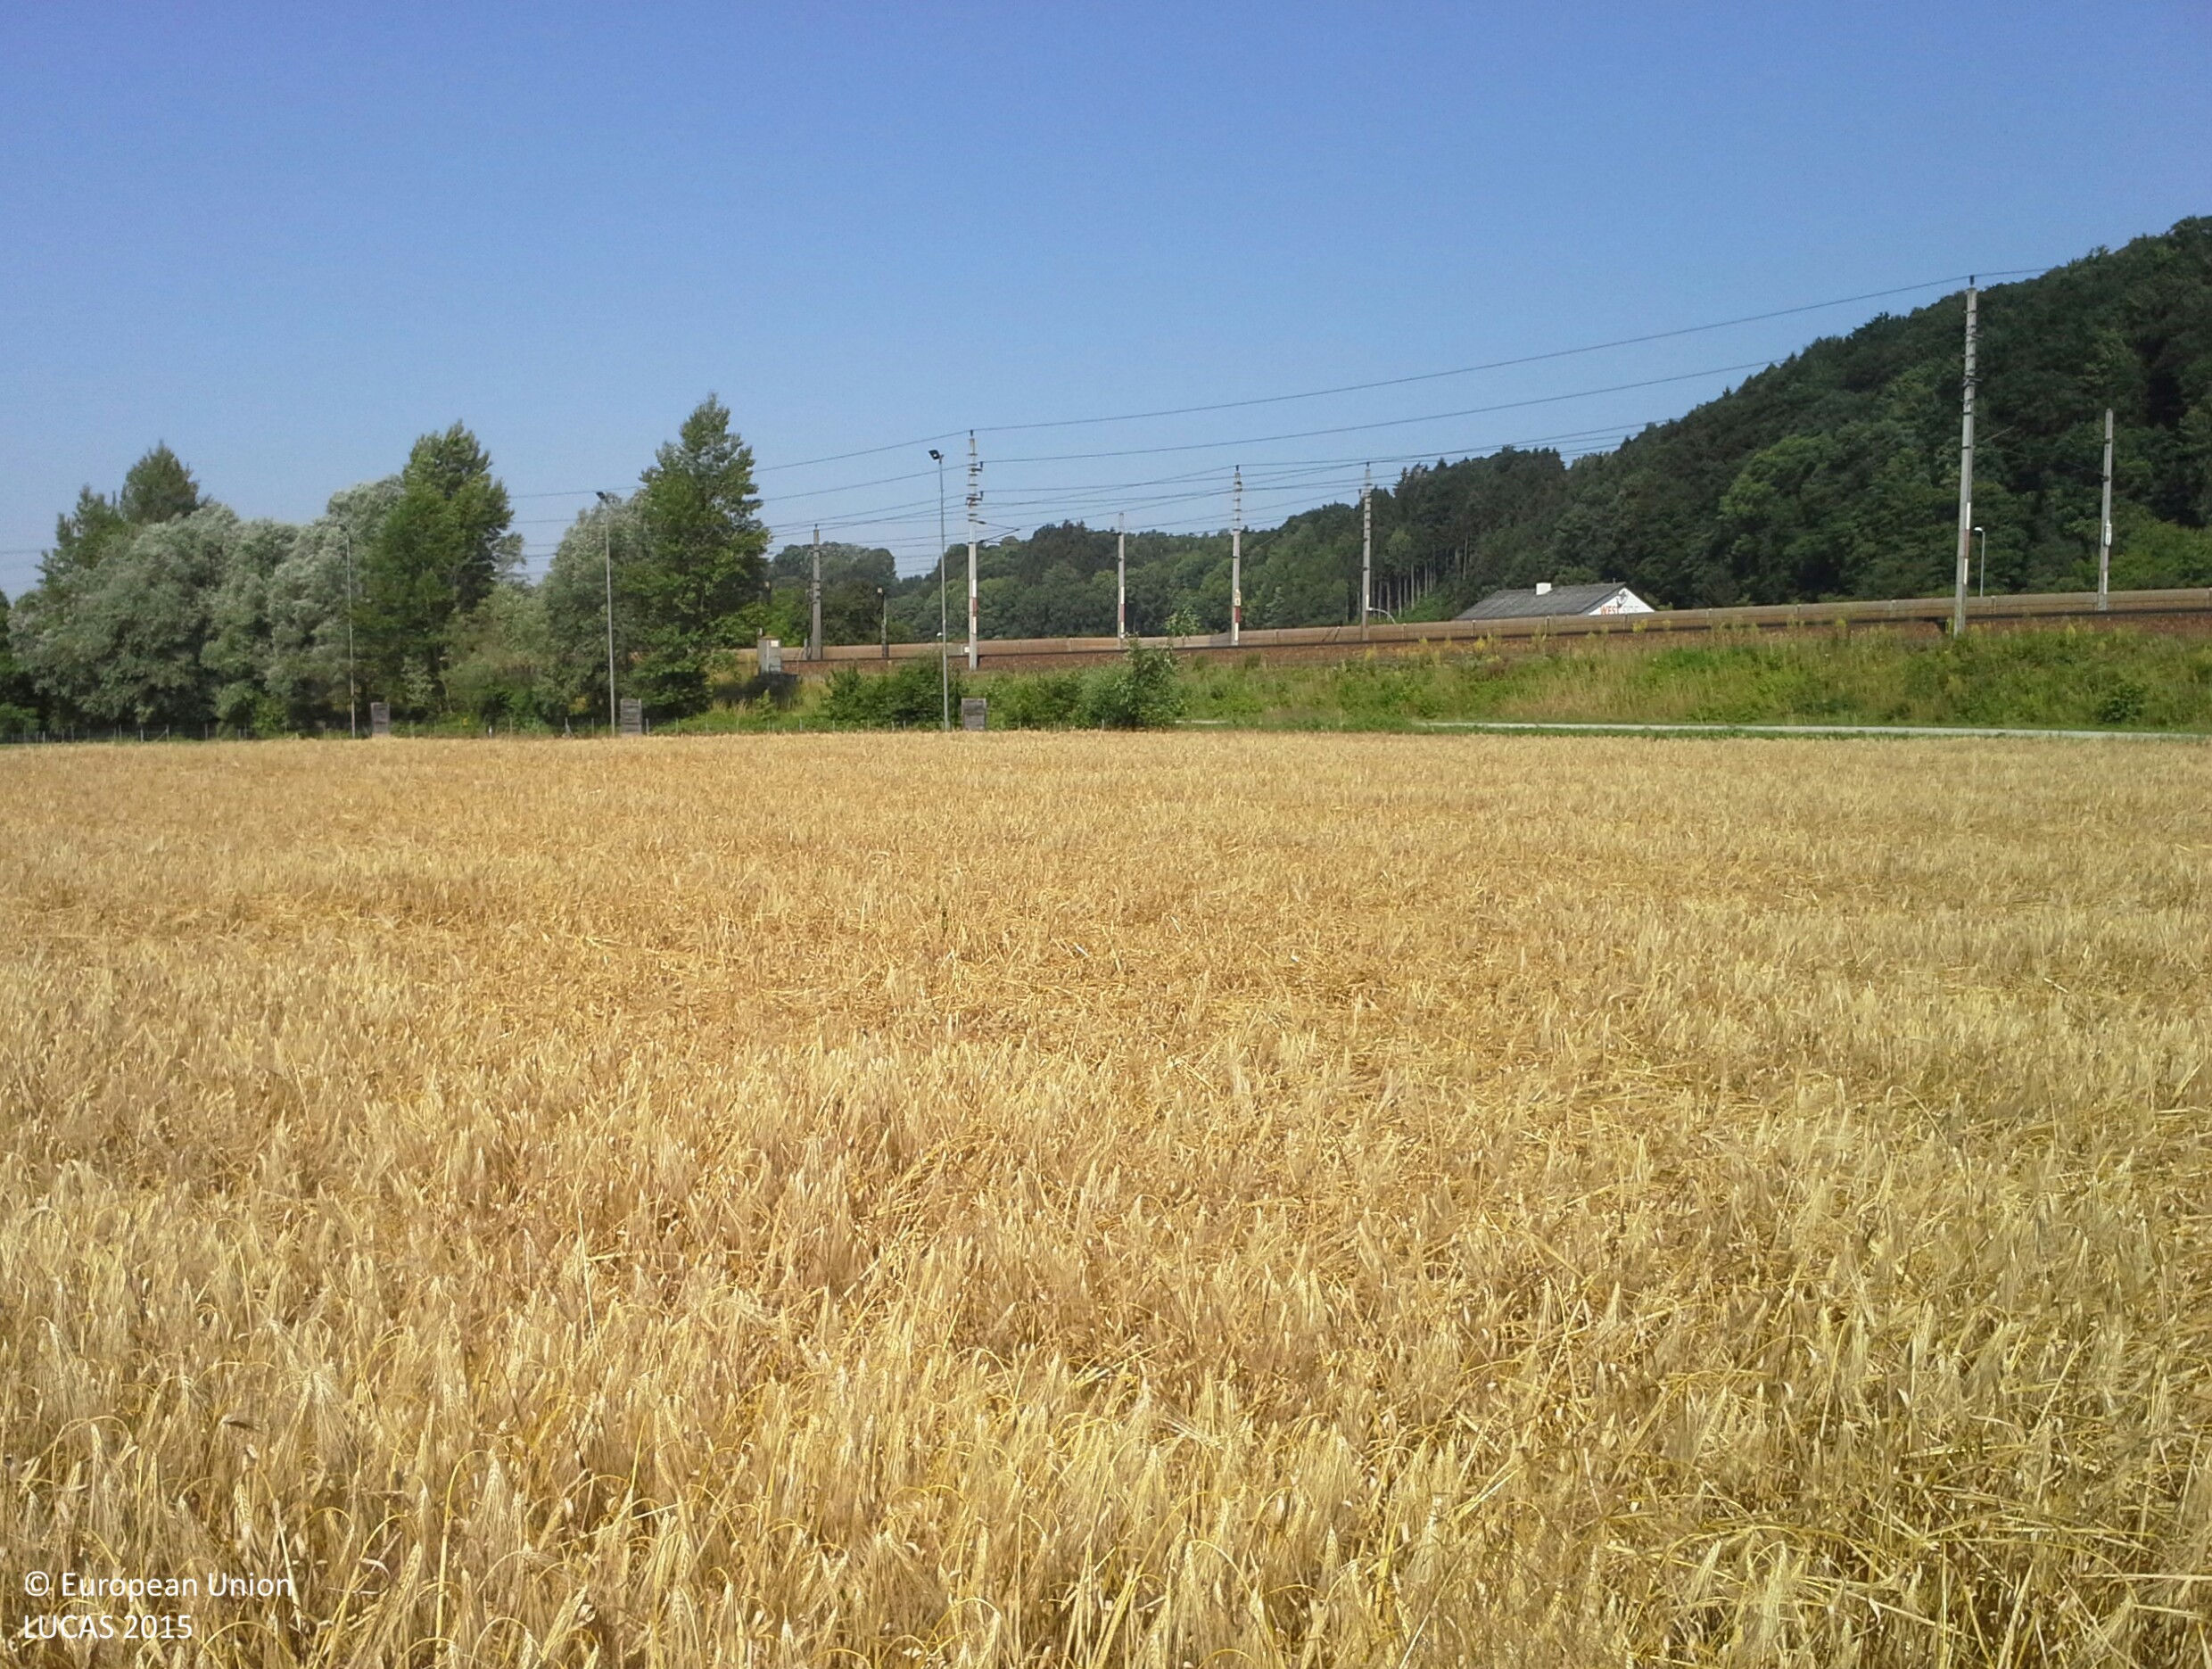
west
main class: Cropland
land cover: Barley
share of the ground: > 75 %
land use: Agriculture (excluding fallow land and kitchen gardens)
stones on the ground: 25 - 50 %
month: July
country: AT
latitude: 48.1168
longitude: 14.8500
